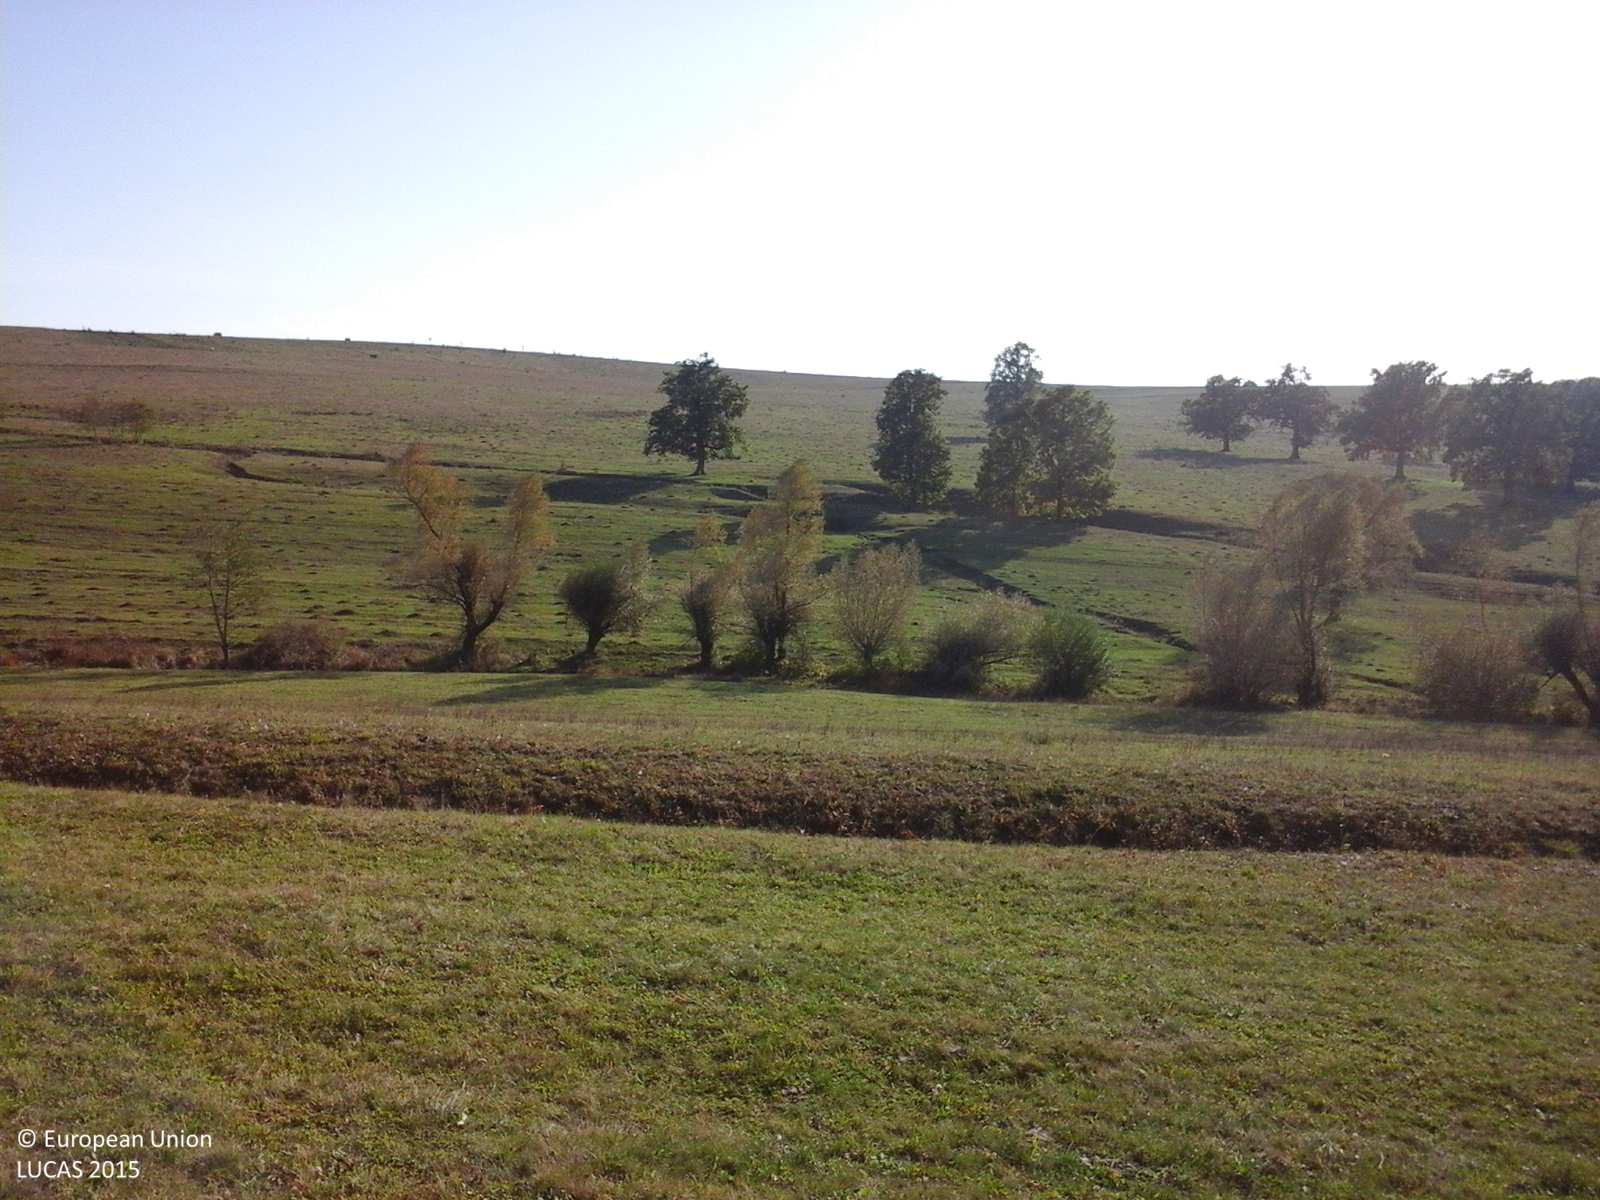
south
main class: Grassland
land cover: Grassland without tree/shrub cover
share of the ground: > 75 %
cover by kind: herbaceous plants 100 %
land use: Agriculture (excluding fallow land and kitchen gardens)
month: October
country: RO
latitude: 46.1111
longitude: 25.6218
